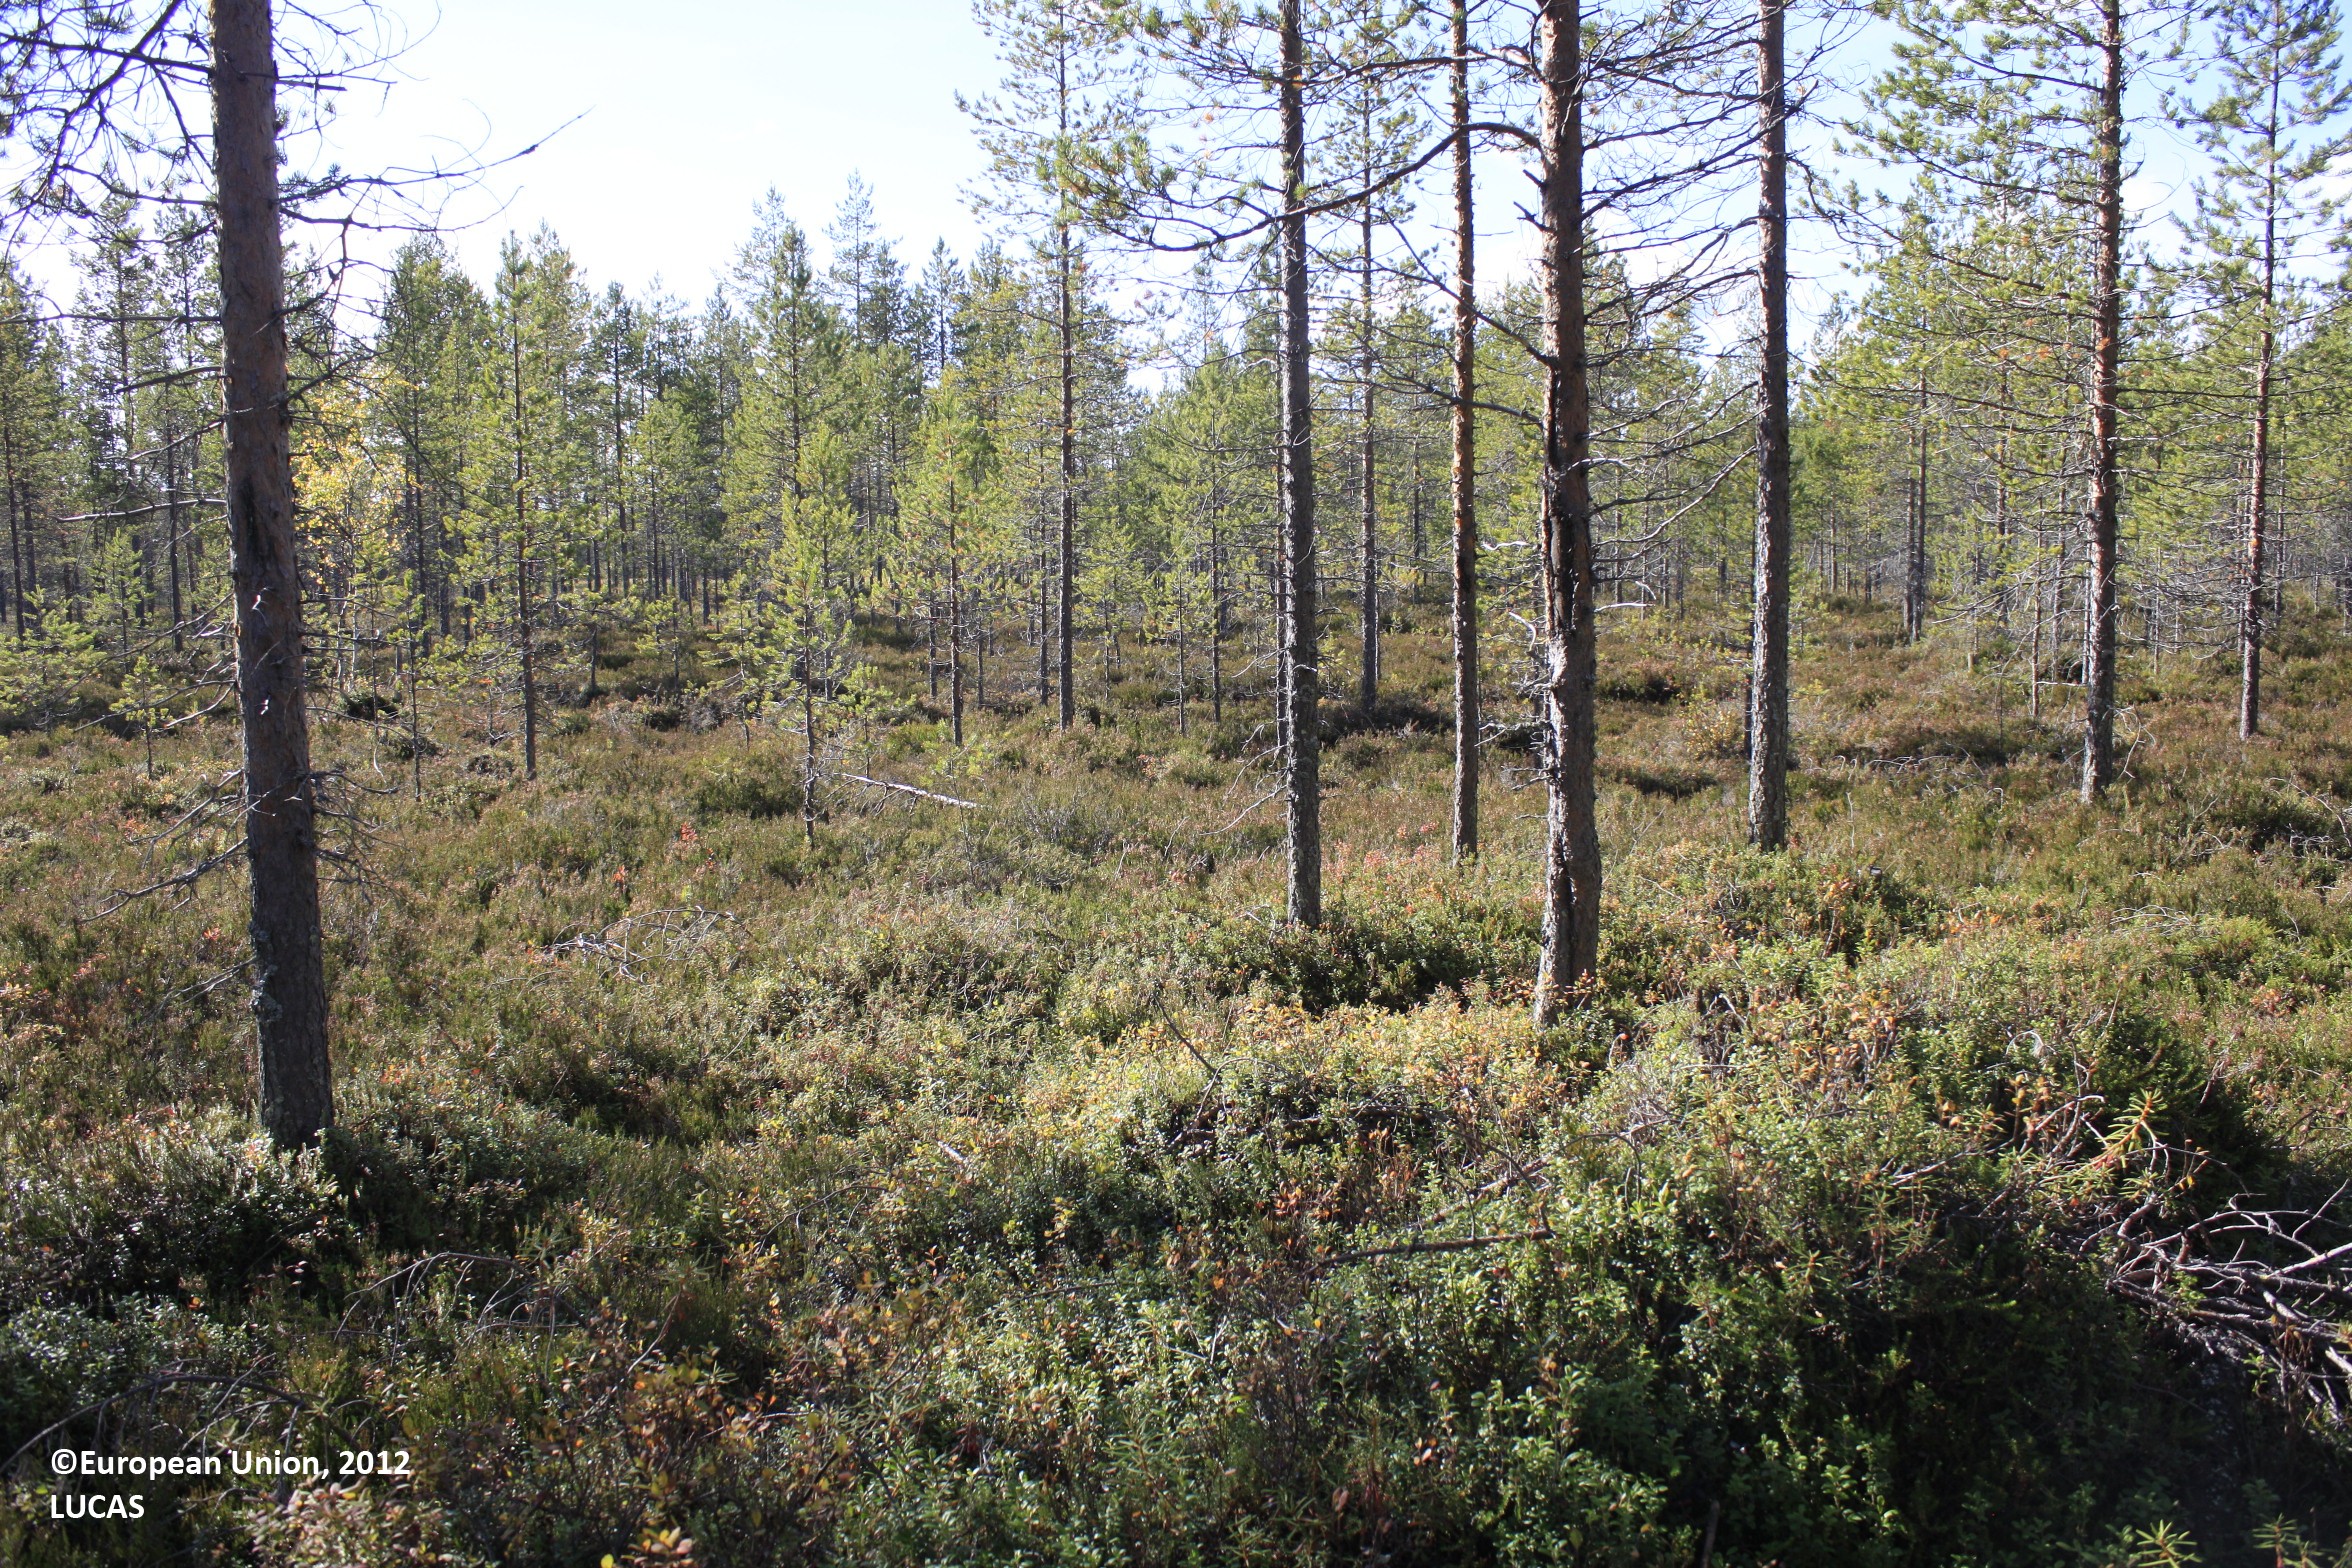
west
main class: Woodland
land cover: Pine dominated coniferous woodland
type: boreal forest
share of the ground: < 10 %
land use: Forestry
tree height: > 5 m
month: September
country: FI
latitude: 65.5018
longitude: 26.9497
